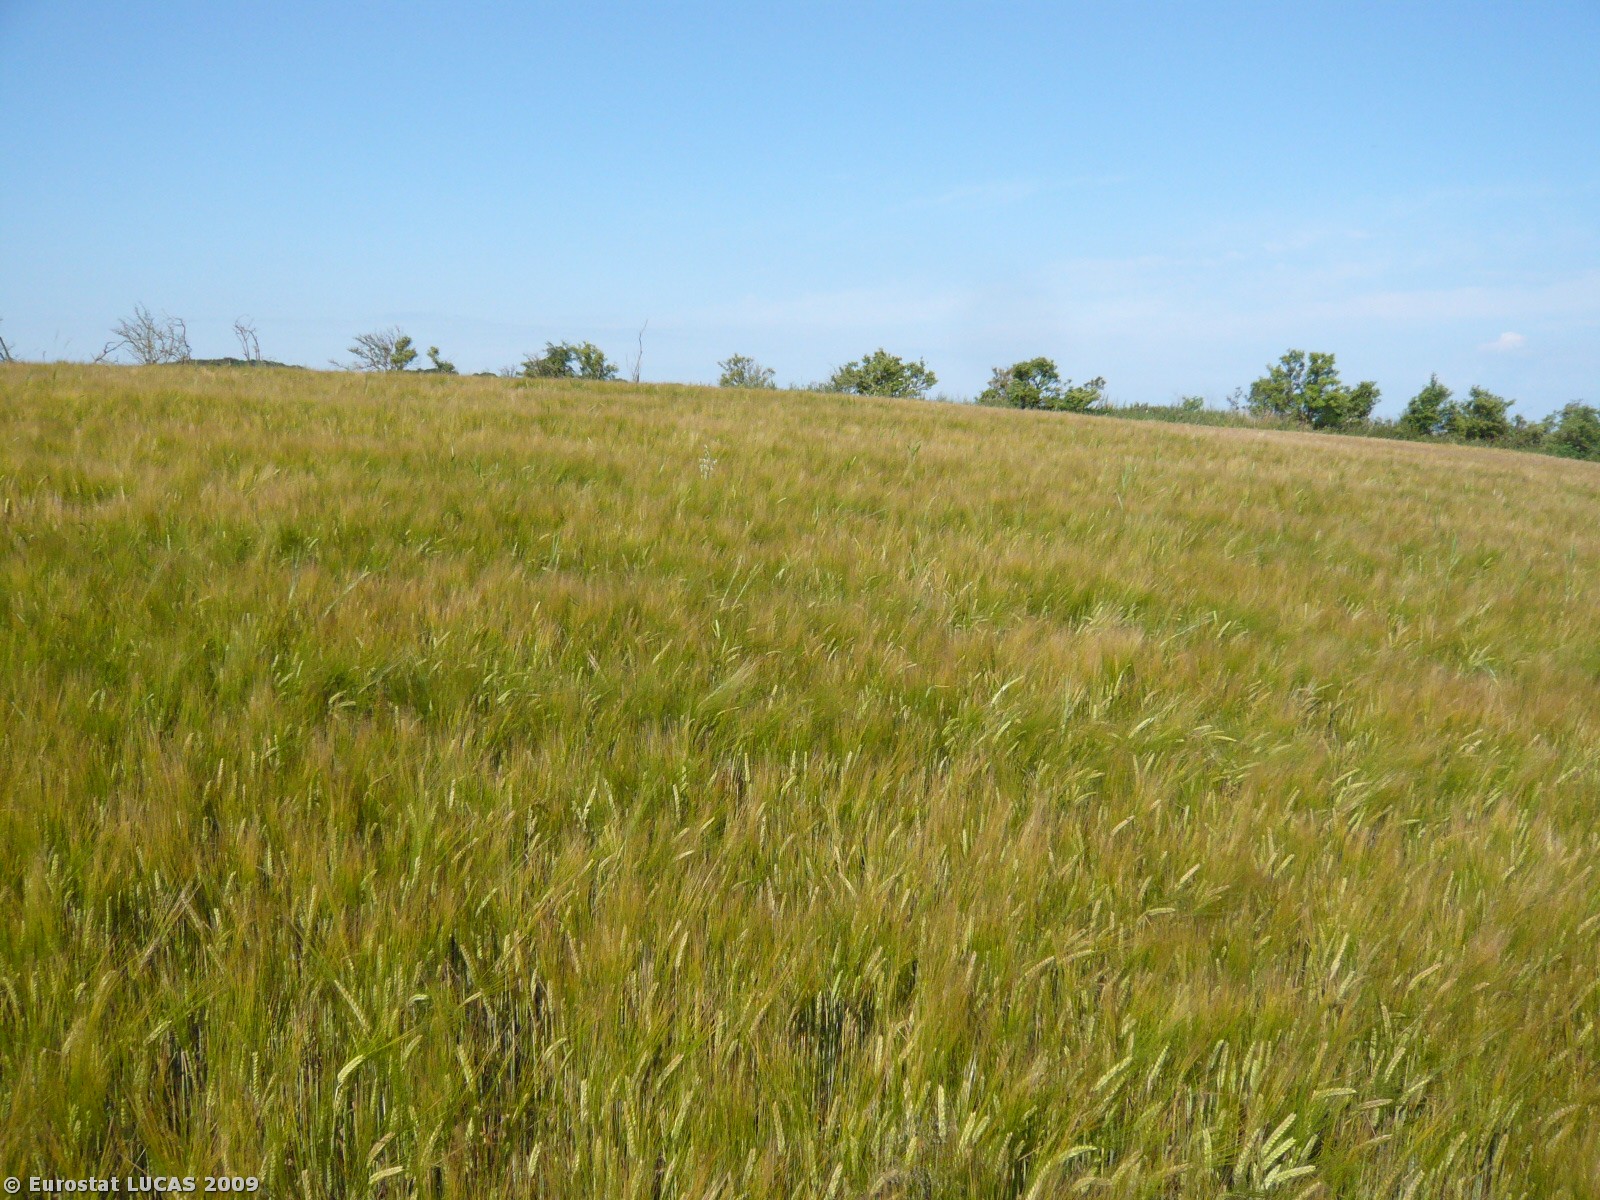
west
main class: Cropland
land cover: Barley
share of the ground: > 75 %
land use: Agriculture (excluding fallow land and kitchen gardens)
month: July
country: DK
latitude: 55.7668
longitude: 11.3853
